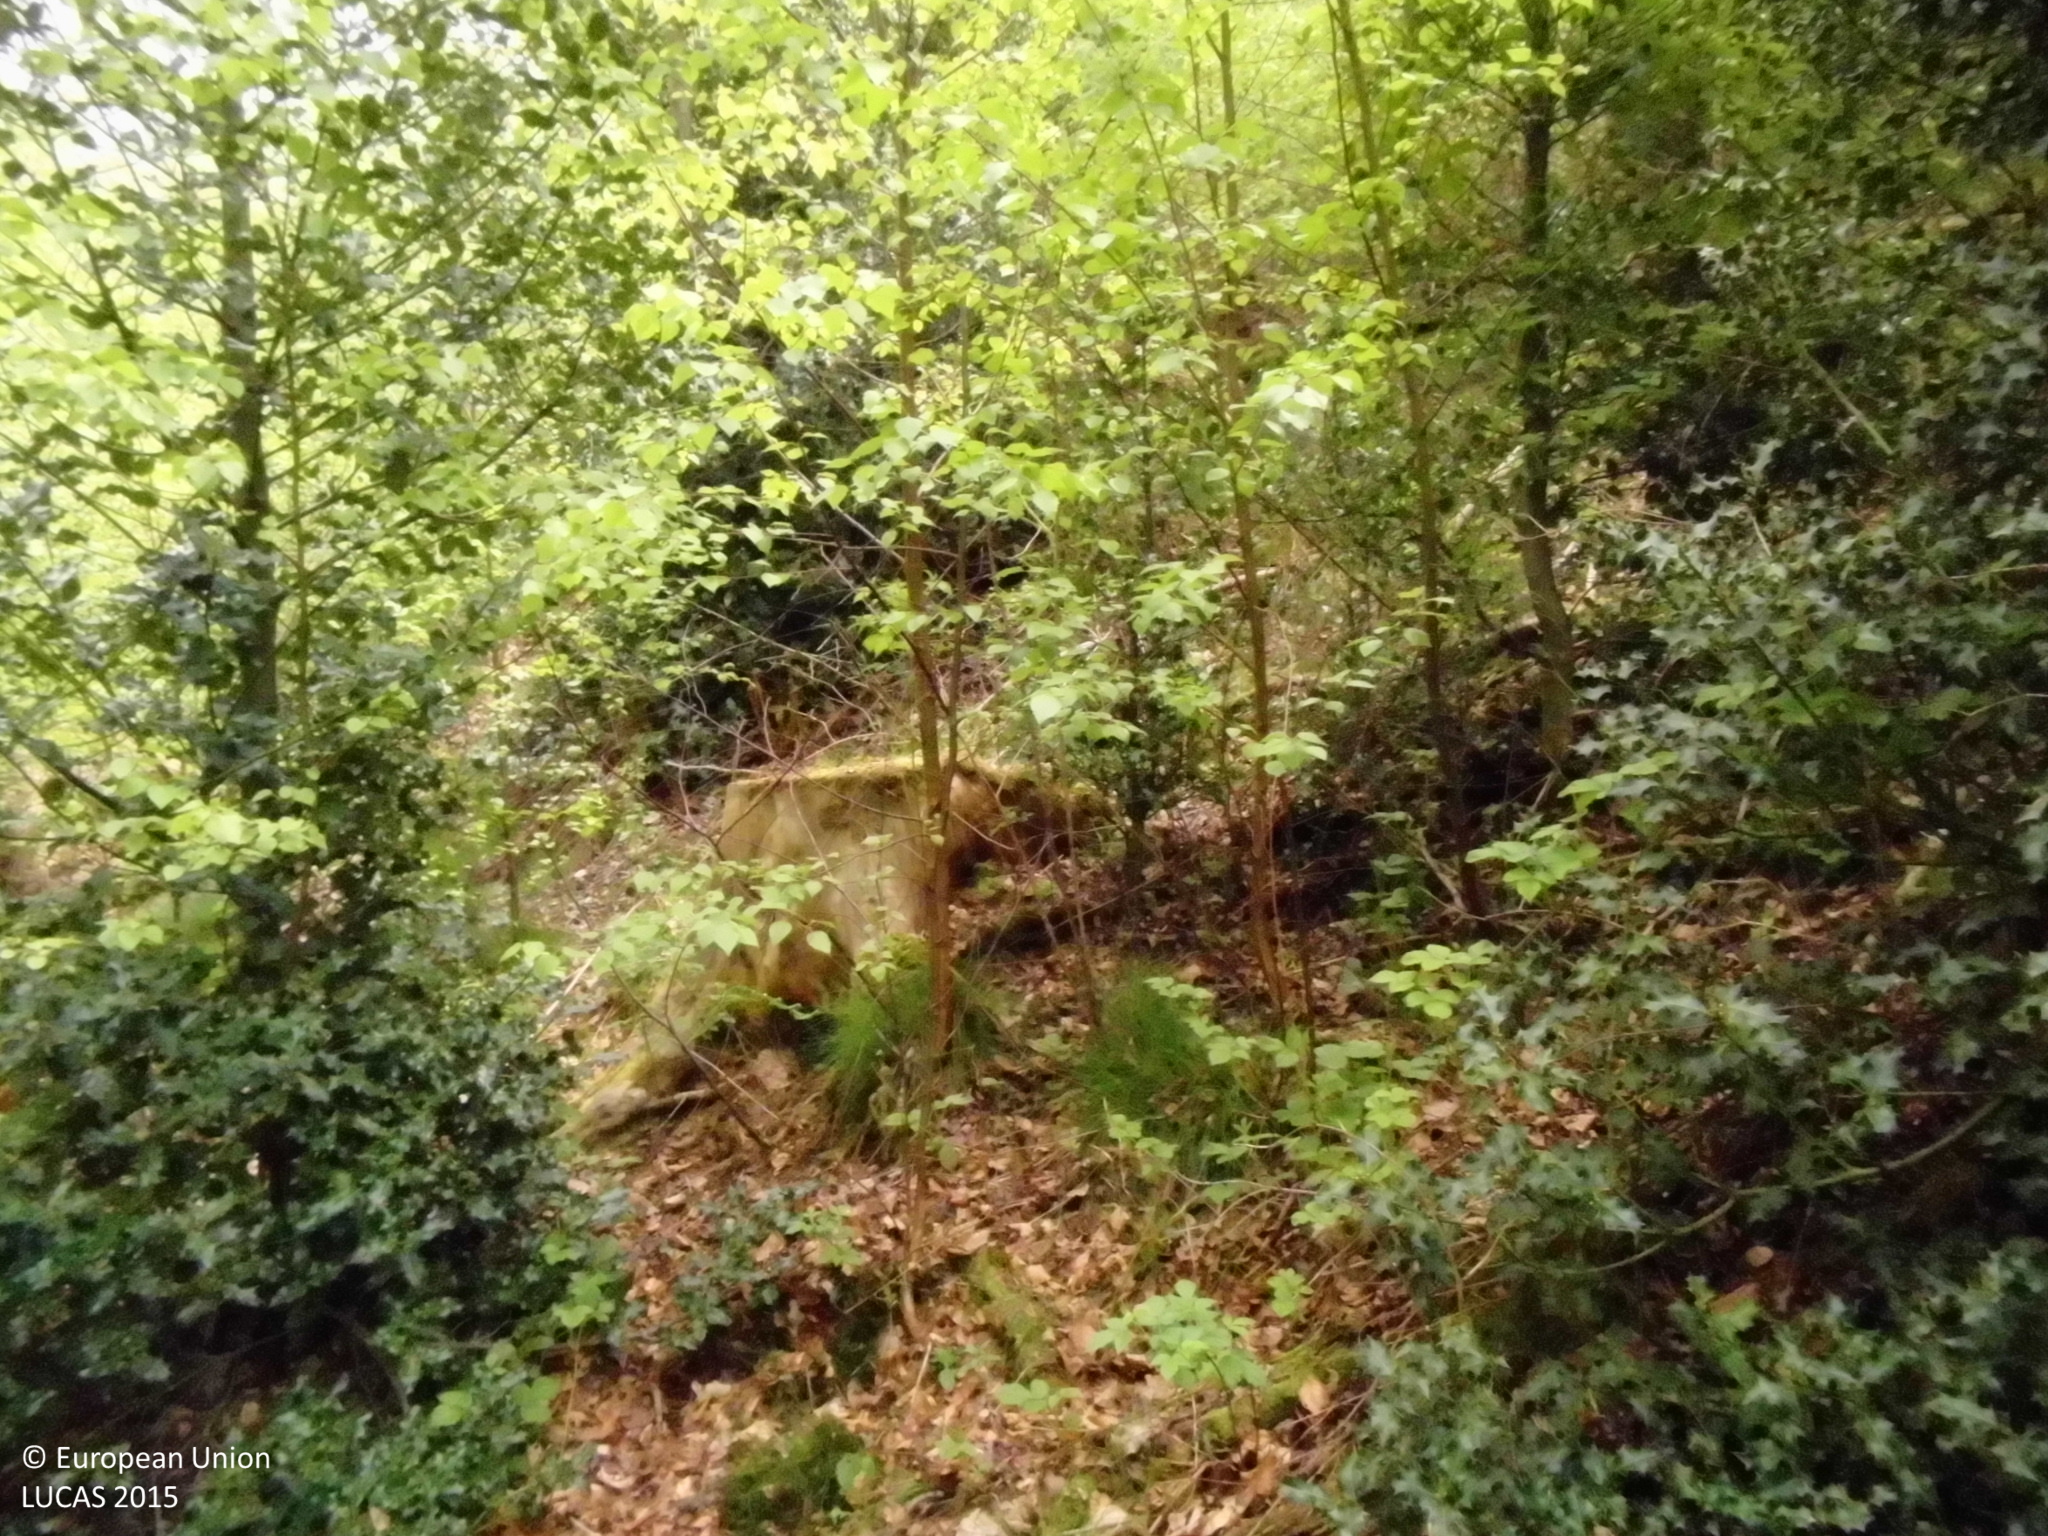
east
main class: Woodland
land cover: Broadleaved woodland
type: mesophytic deciduous forest
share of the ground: > 75 %
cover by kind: broadleaved forest trees 100 %
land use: Forestry
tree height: < 5 m
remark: Nursery
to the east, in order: Broadleaved woodland; Other mixed woodland; Broadleaved woodland
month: May
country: DE
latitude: 51.3060
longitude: 7.4038
